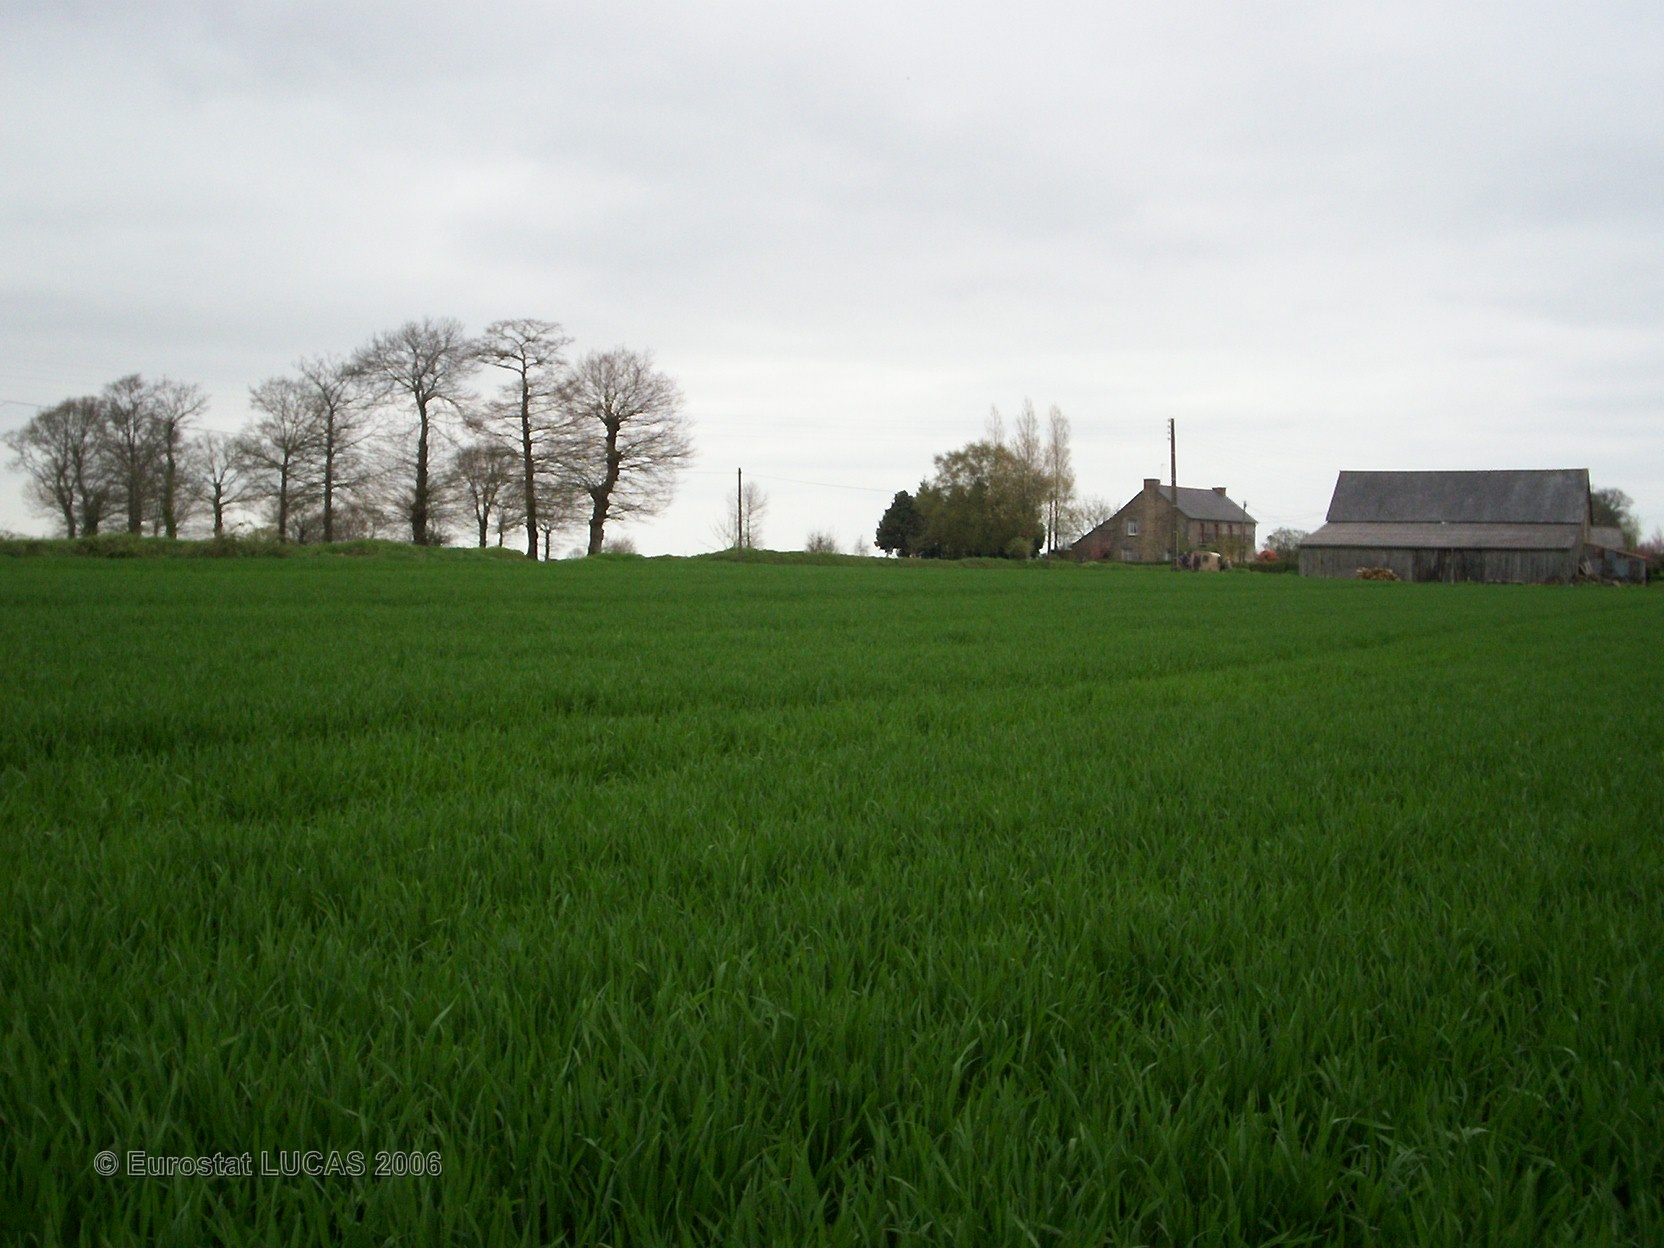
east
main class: Cropland
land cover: Common wheat
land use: Agriculture (excluding fallow land and kitchen gardens)
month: April
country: FR
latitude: 48.2414
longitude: -2.4617
